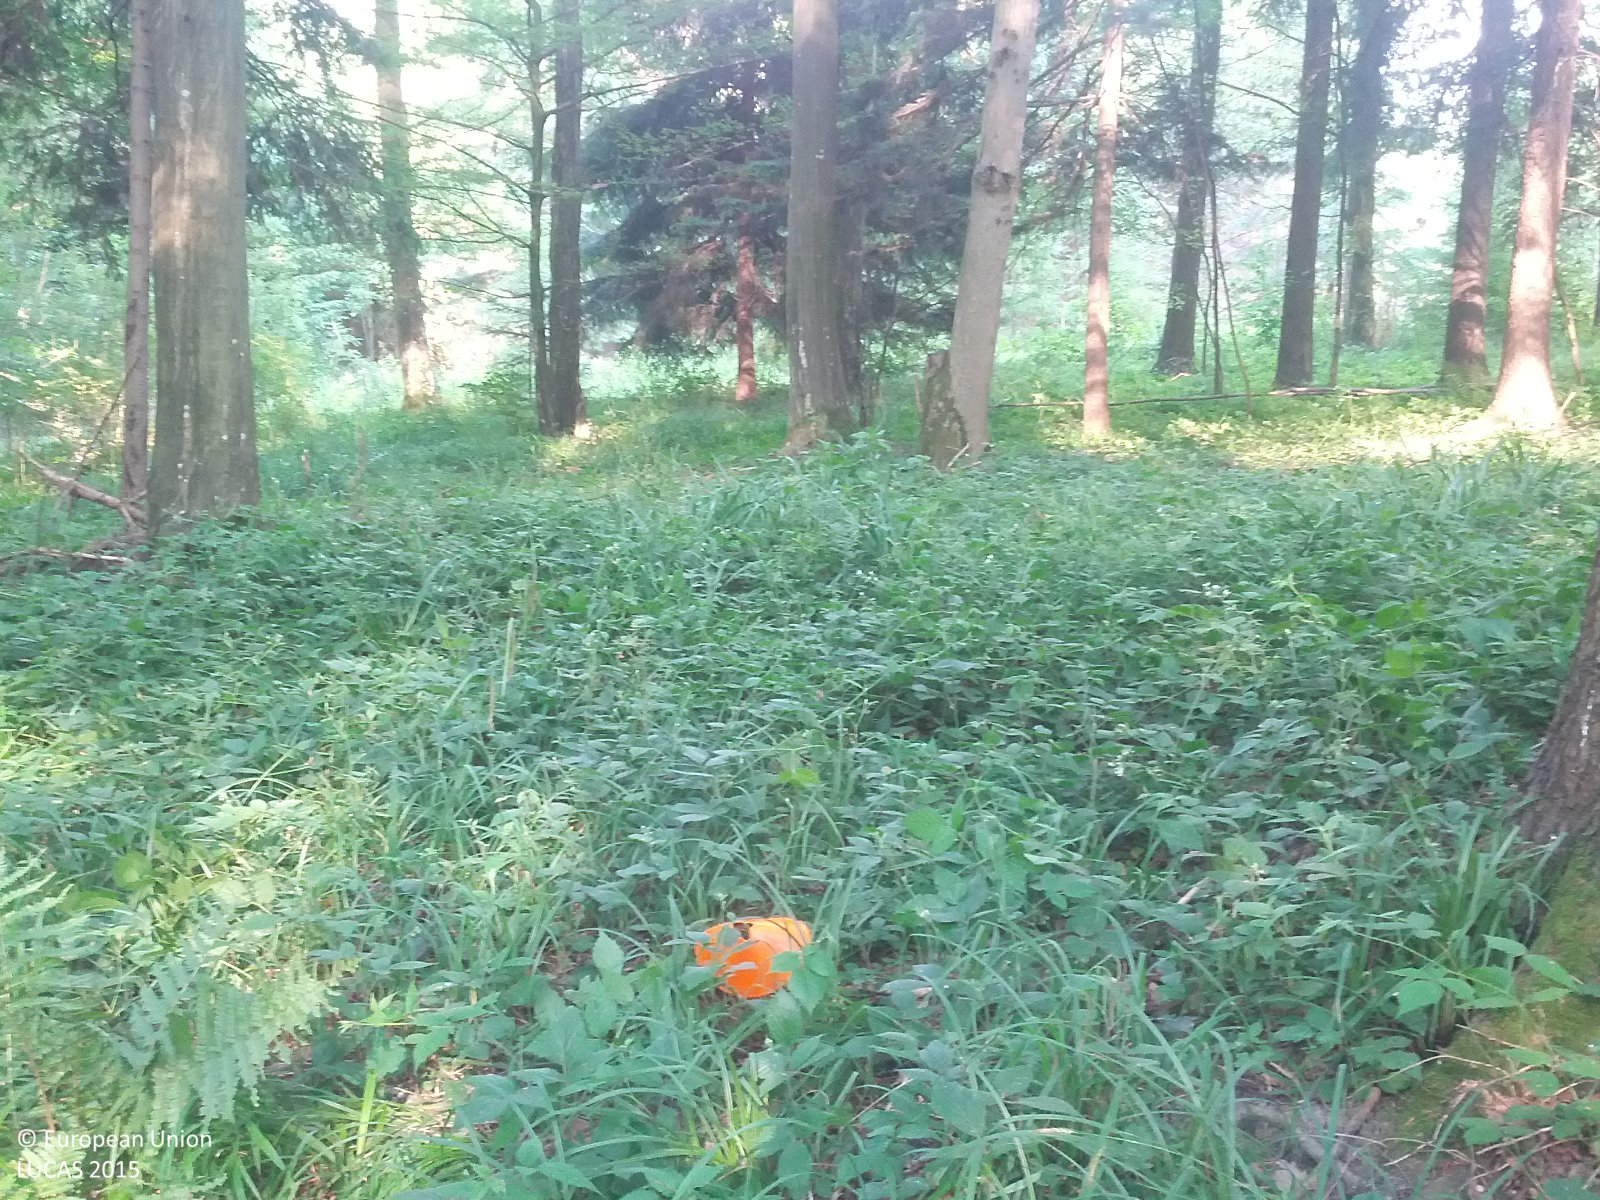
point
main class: Woodland
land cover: Spruce dominated mixed woodland
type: alpine coniferous forest
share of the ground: > 75 %
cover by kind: coniferous forest trees 60 %, broadleaved forest trees 30 %, herbaceous plants 5 %, lichens and mosses 5 %
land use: Forestry
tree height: > 5 m
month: June
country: AT
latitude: 48.1647
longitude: 16.0677
